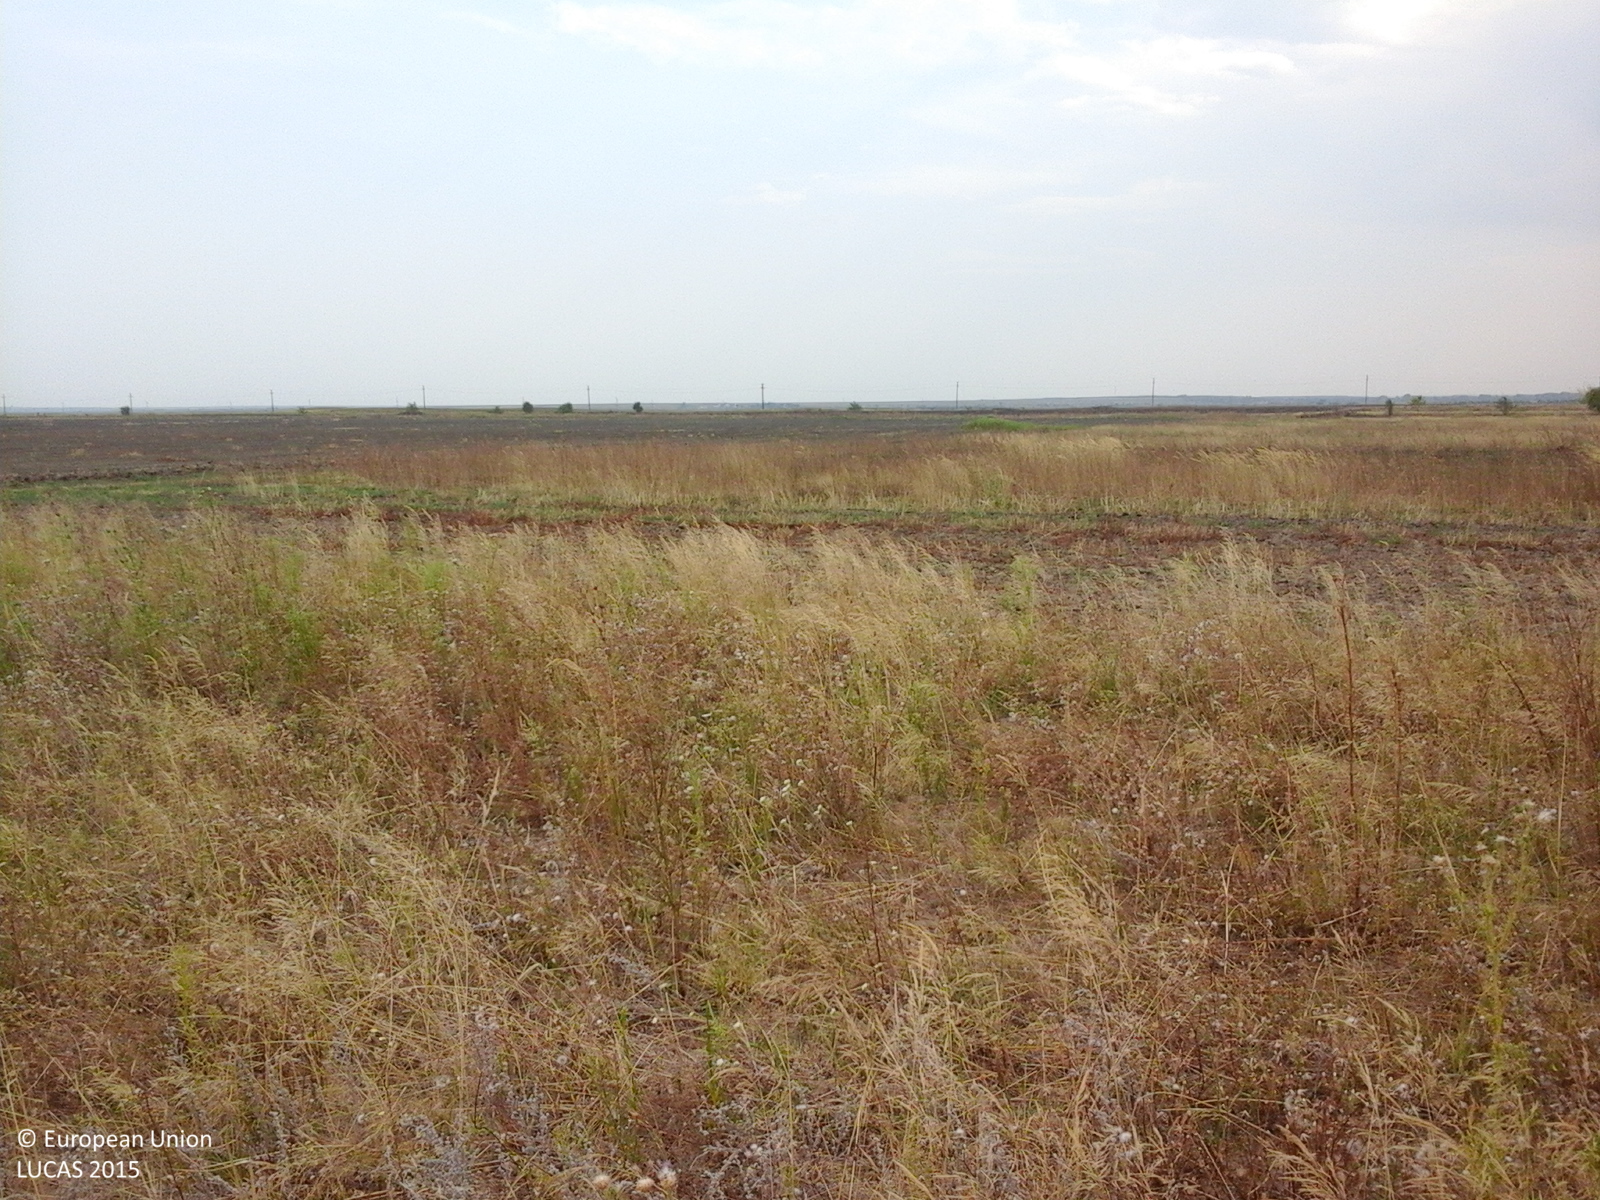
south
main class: Grassland
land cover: Spontaneously vegetated surfaces
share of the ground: > 75 %
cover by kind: herbaceous plants 100 %
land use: Fallow land
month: August
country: RO
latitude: 44.4546
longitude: 22.7469
